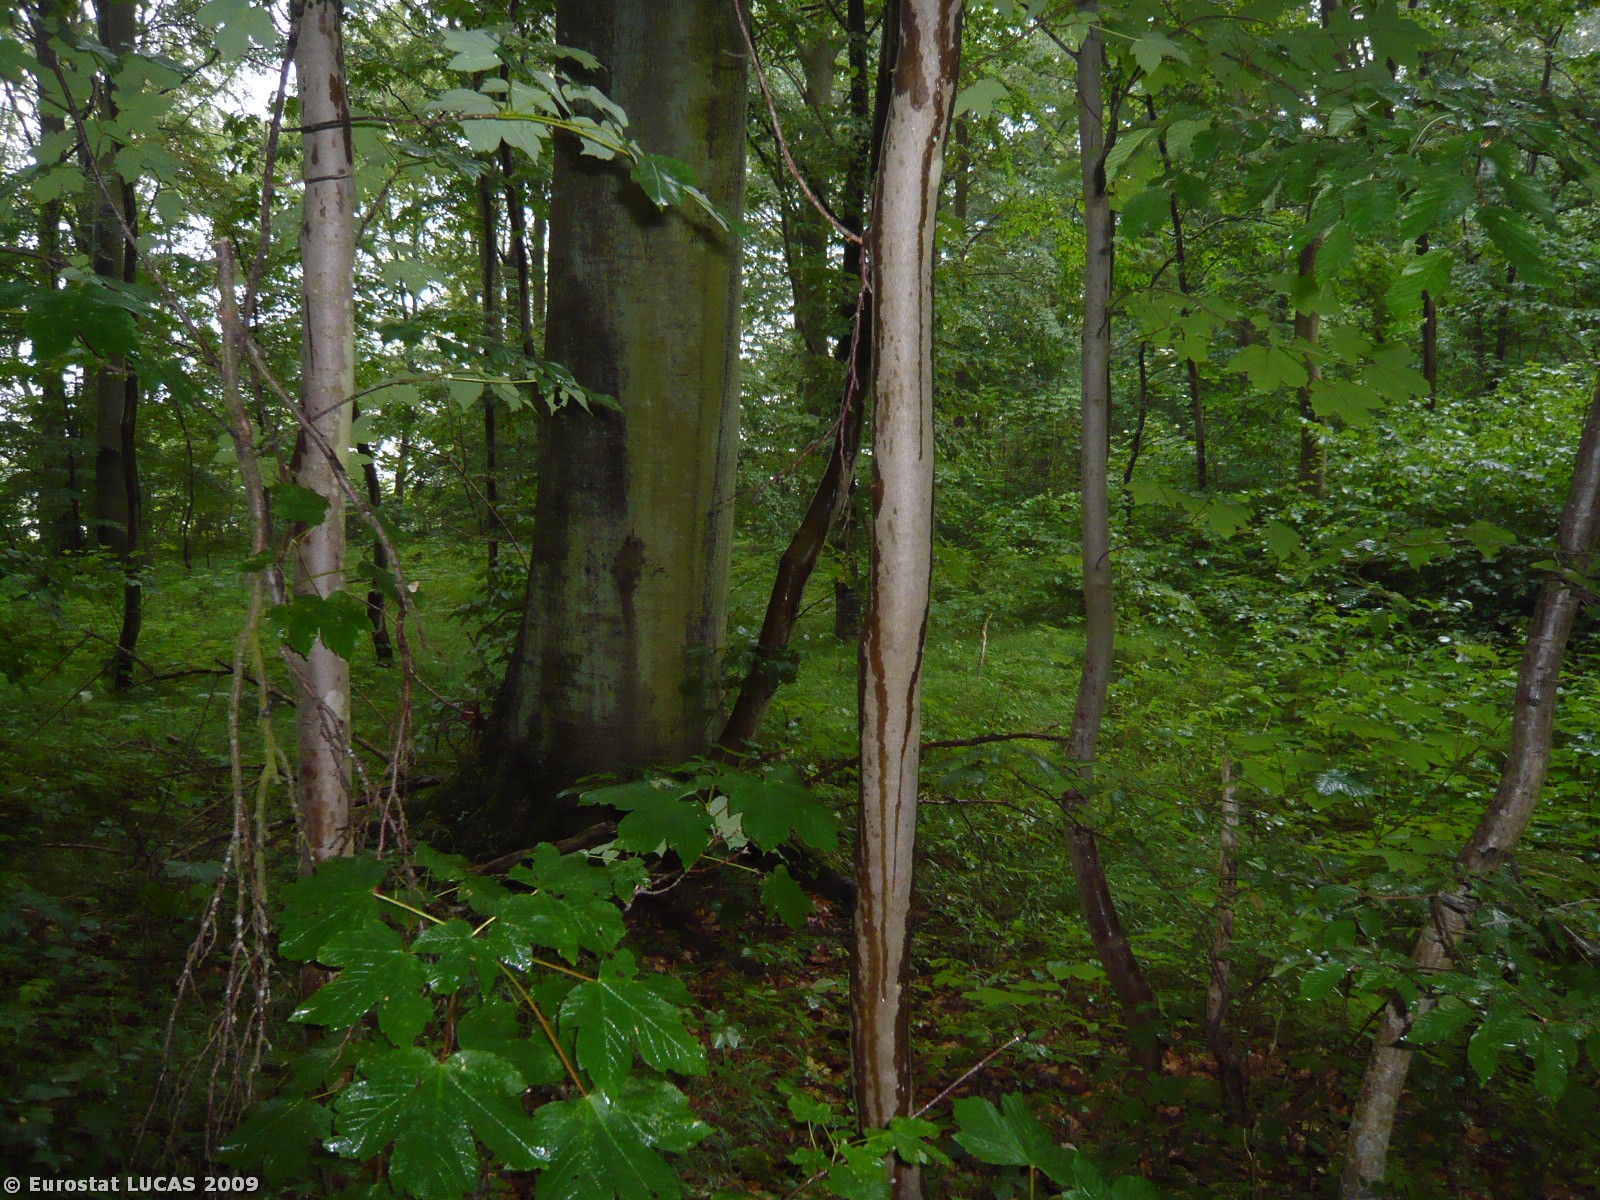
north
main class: Woodland
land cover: Broadleaved woodland
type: mesophytic deciduous forest
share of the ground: > 75 %
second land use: Amenities, museums, leisure
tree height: > 5 m
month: June
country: DK
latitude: 54.7914
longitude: 11.7563
